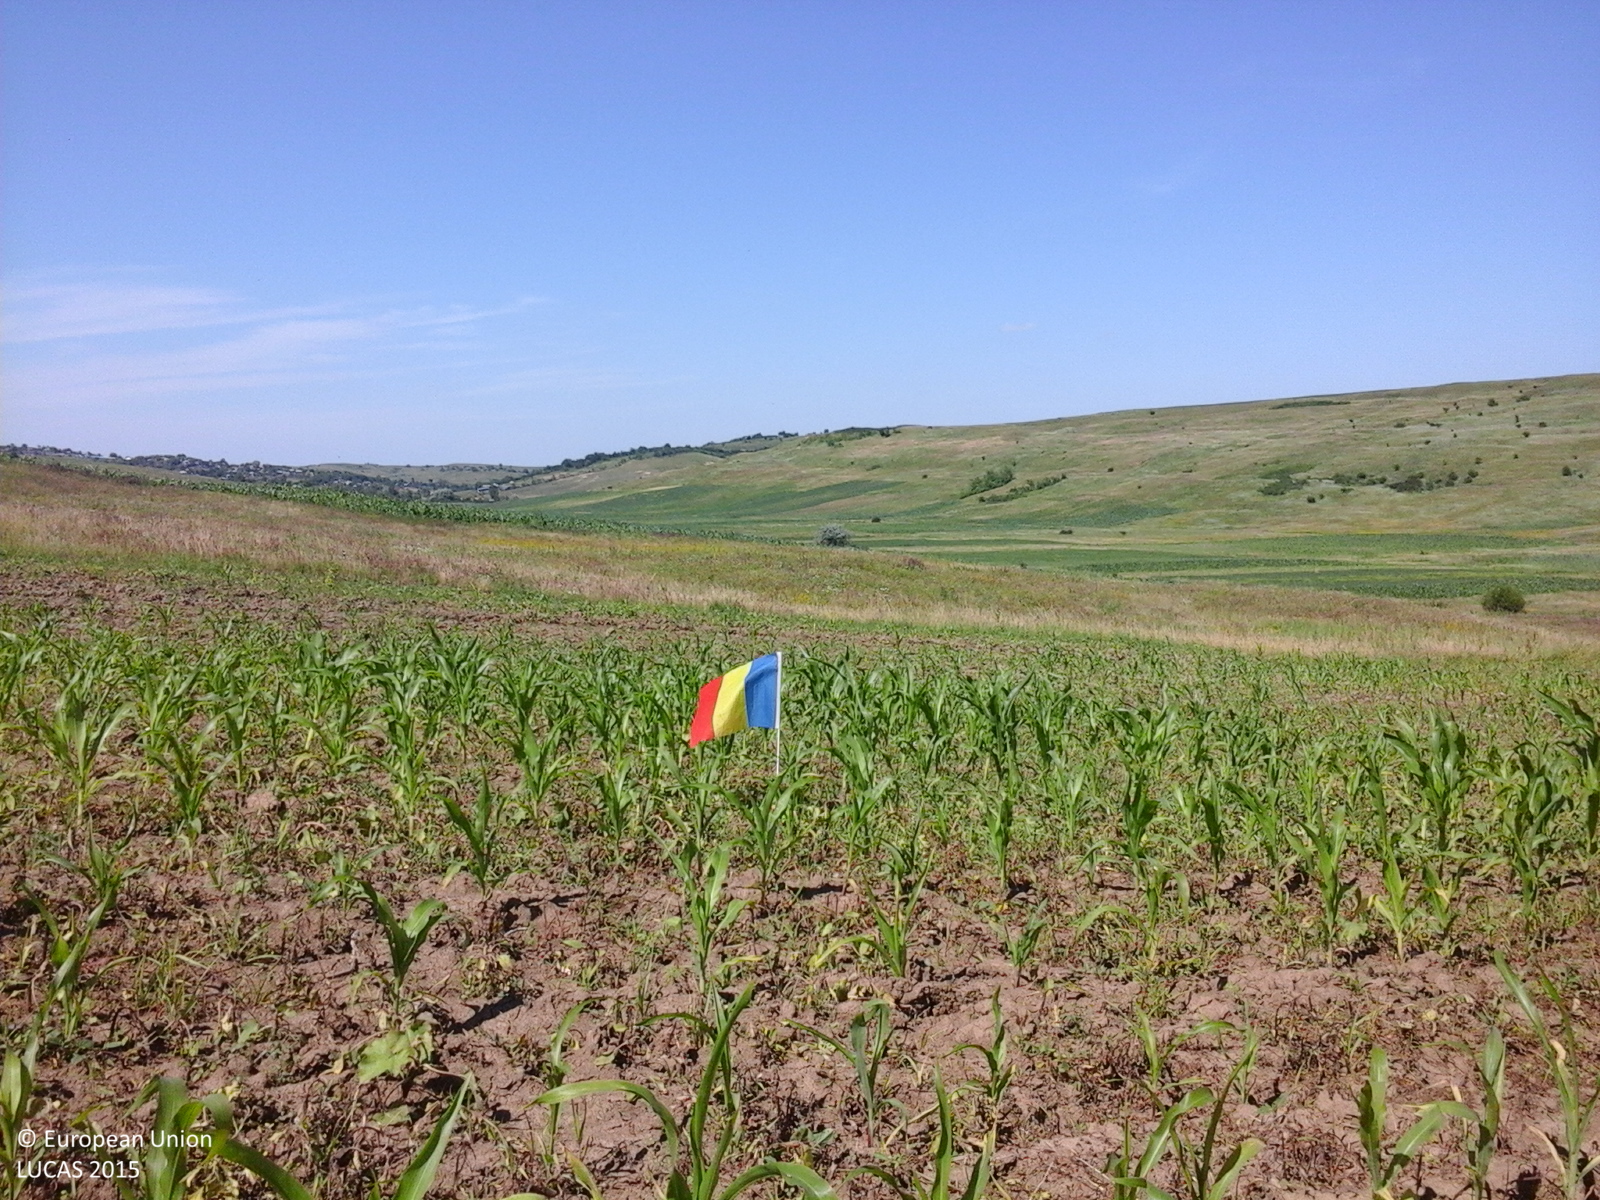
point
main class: Cropland
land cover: Maize
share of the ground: 25 - 50 %
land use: Agriculture (excluding fallow land and kitchen gardens)
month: June
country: RO
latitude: 47.1320
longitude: 27.0970
